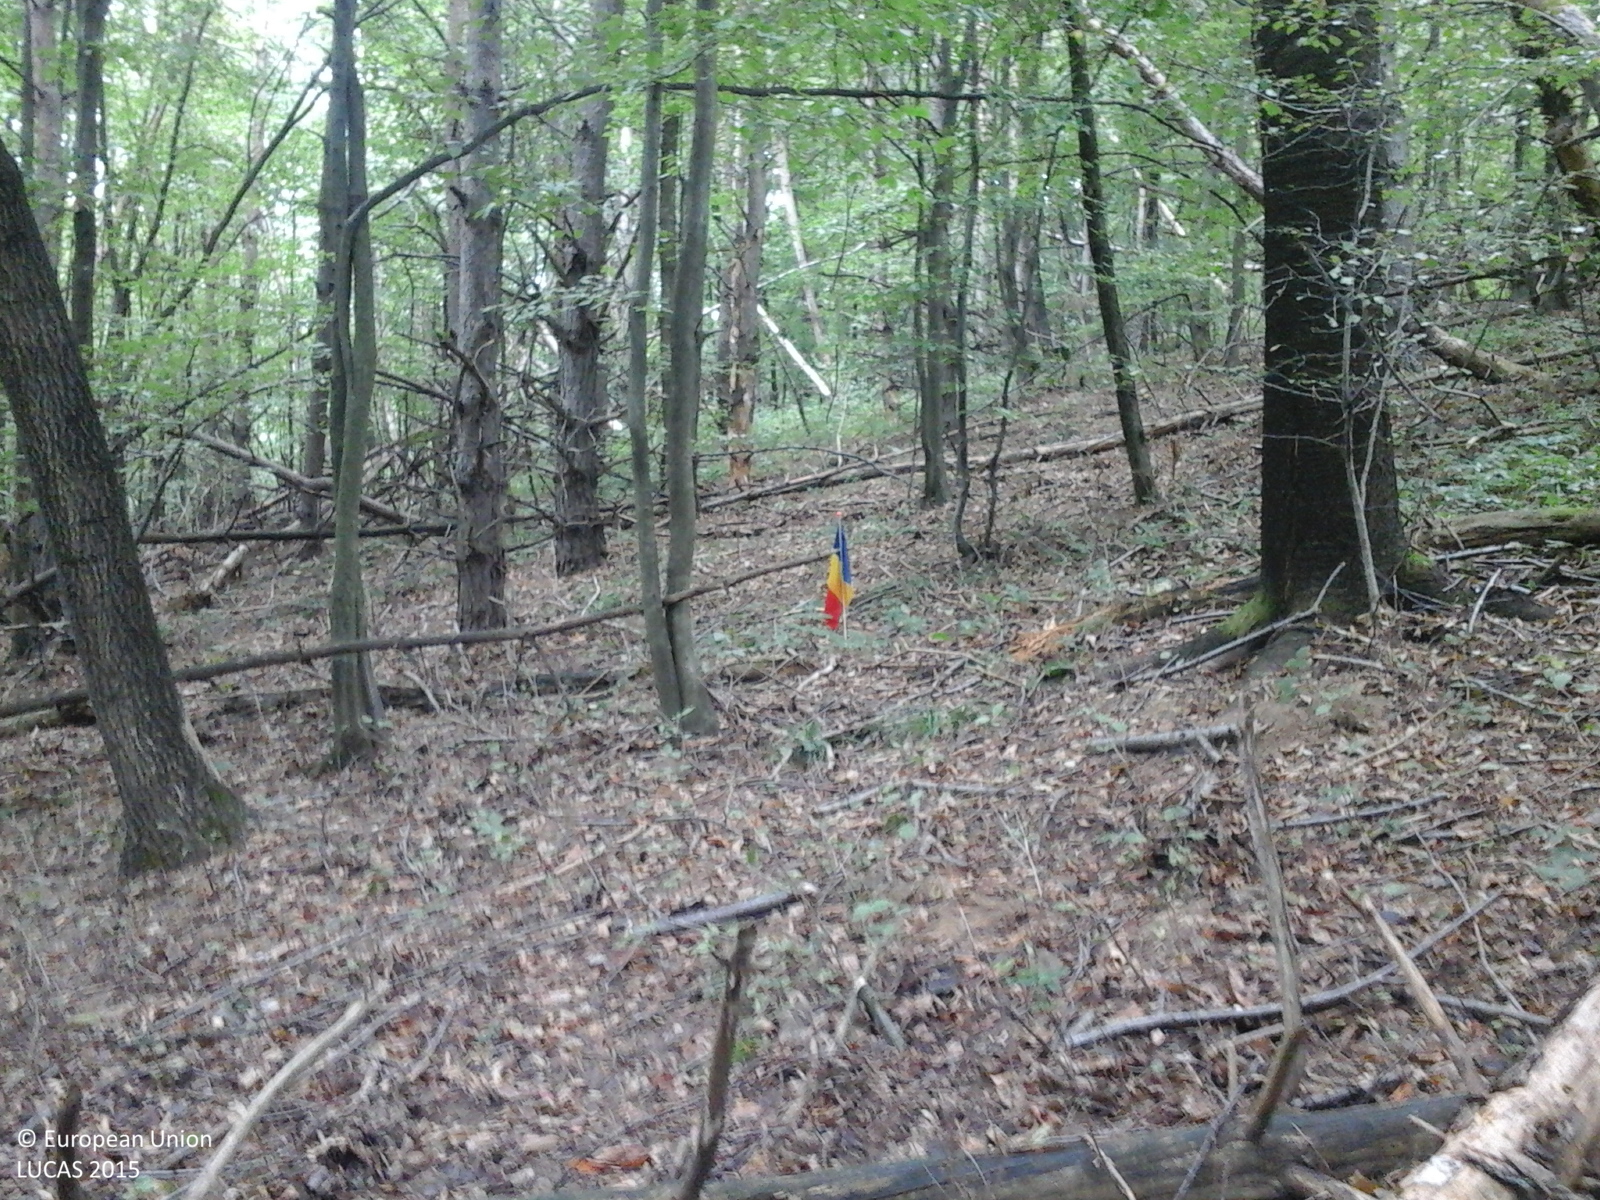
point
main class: Woodland
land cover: Broadleaved woodland
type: mesophytic deciduous forest
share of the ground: > 75 %
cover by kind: broadleaved forest trees 100 %
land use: Forestry
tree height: > 5 m
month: September
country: RO
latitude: 47.1815
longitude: 22.3381
